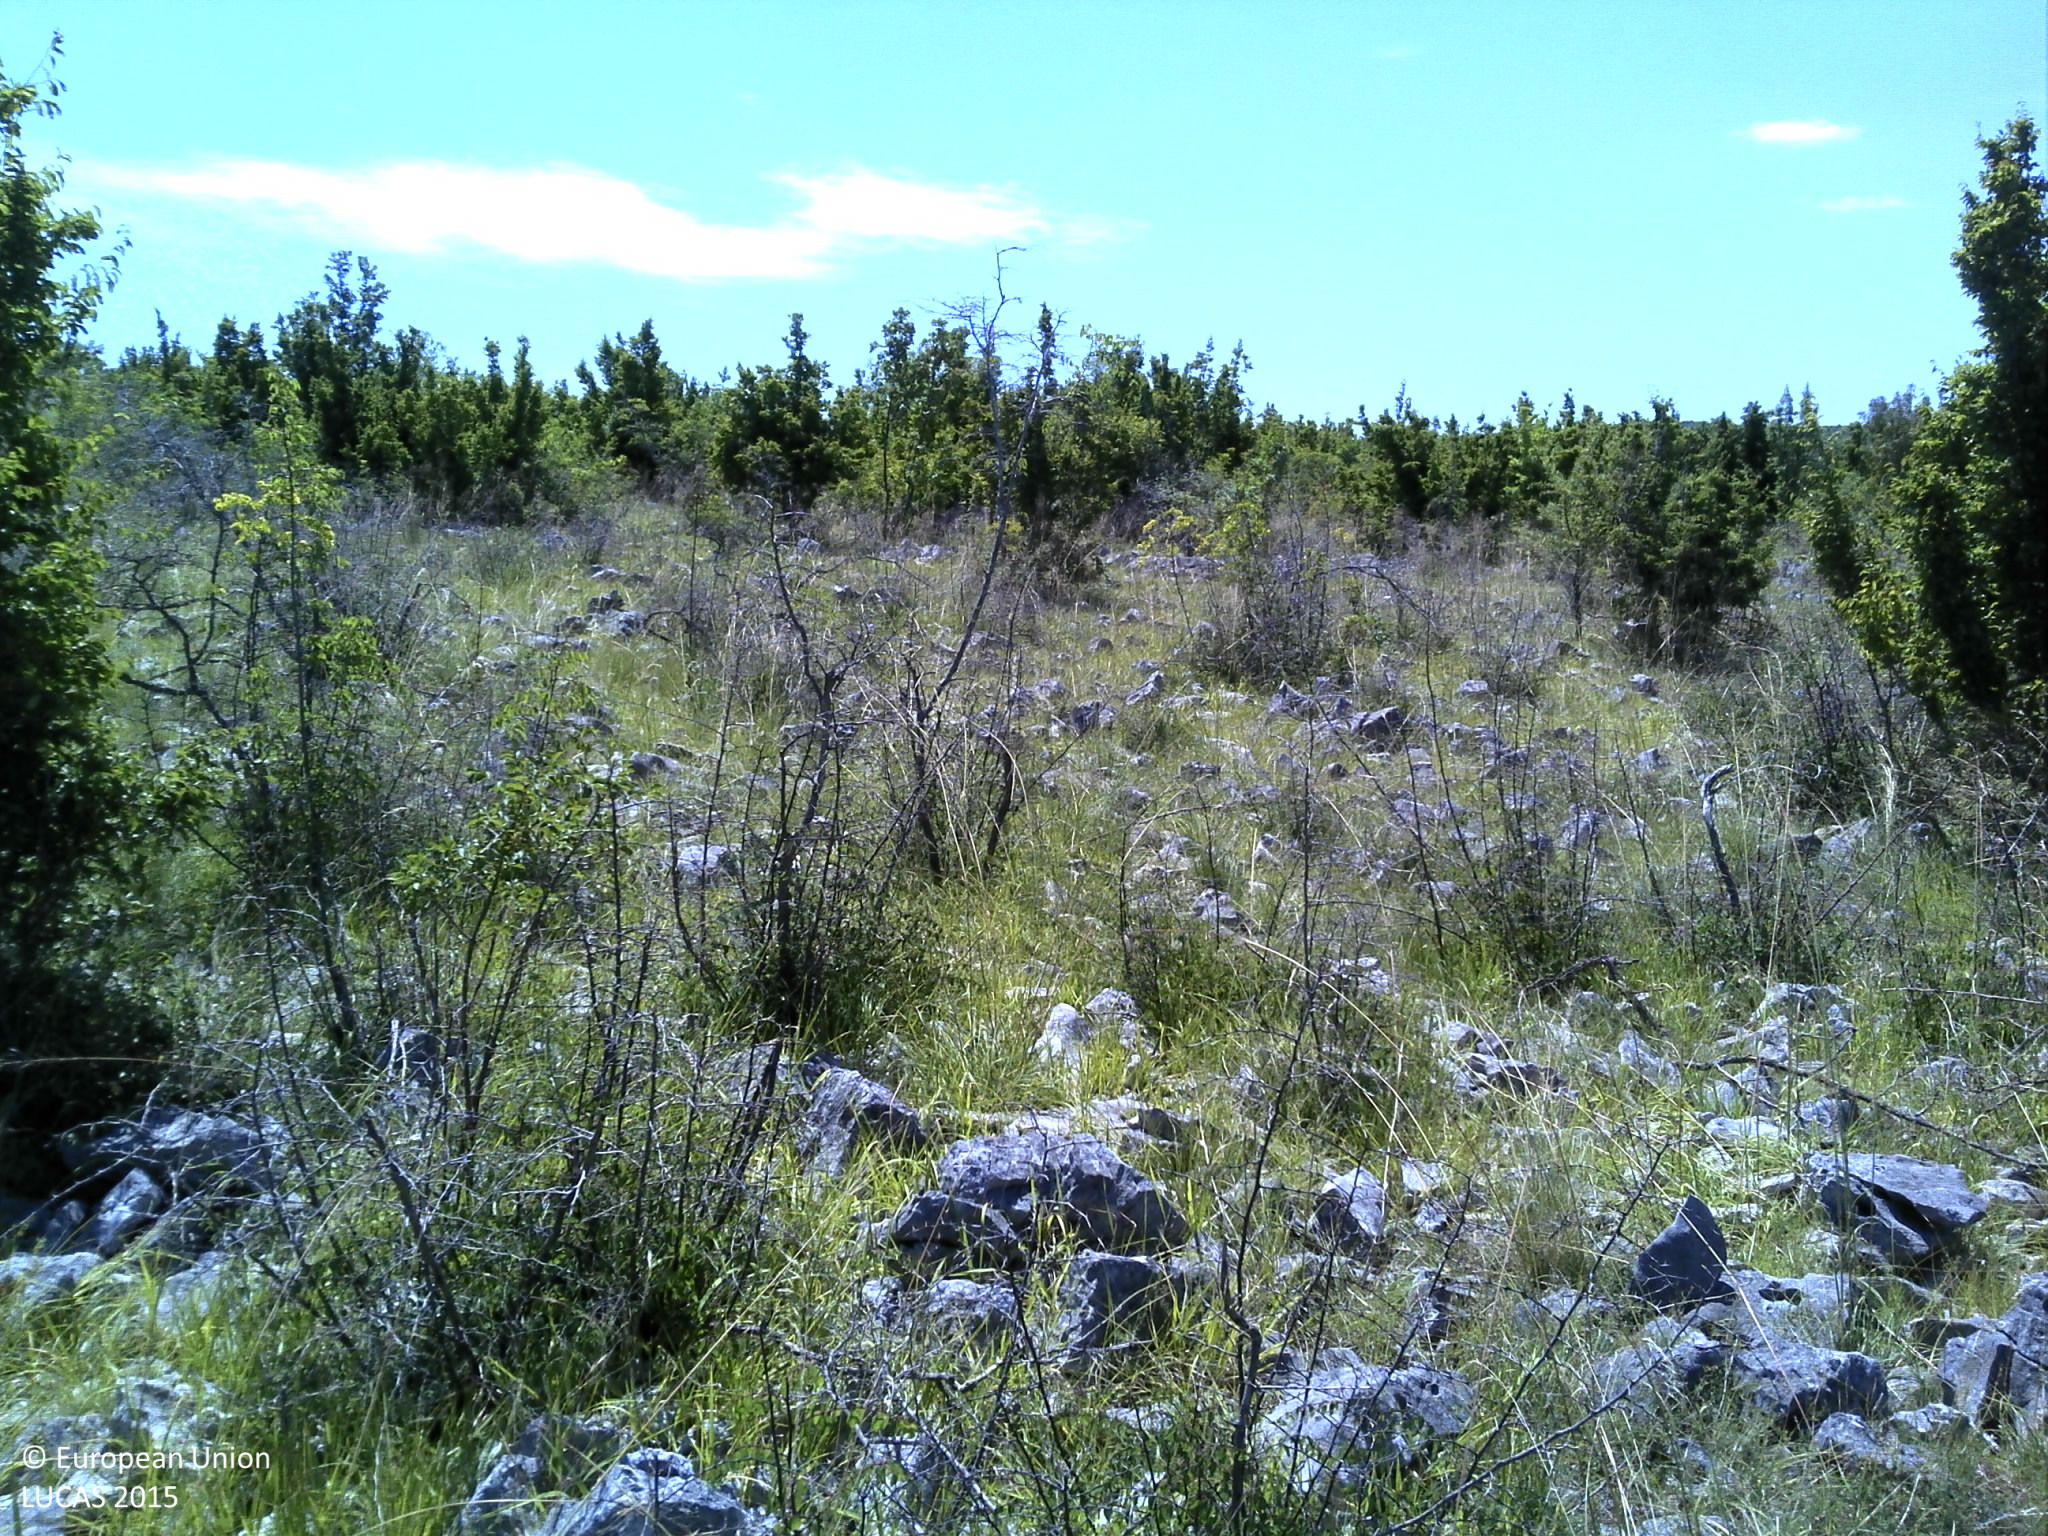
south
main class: Shrubland
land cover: Shrubland with sparse tree cover
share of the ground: 50 - 75 %
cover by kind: shrubs 35 %, unconsolidated bare surface 30 %, herbaceous plants 20 %, consolidated bare surface 10 %, broadleaved forest trees 5 %
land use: Semi-natural and natural areas not in use
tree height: < 5 m
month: June
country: HR
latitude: 44.0894
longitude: 15.9499
